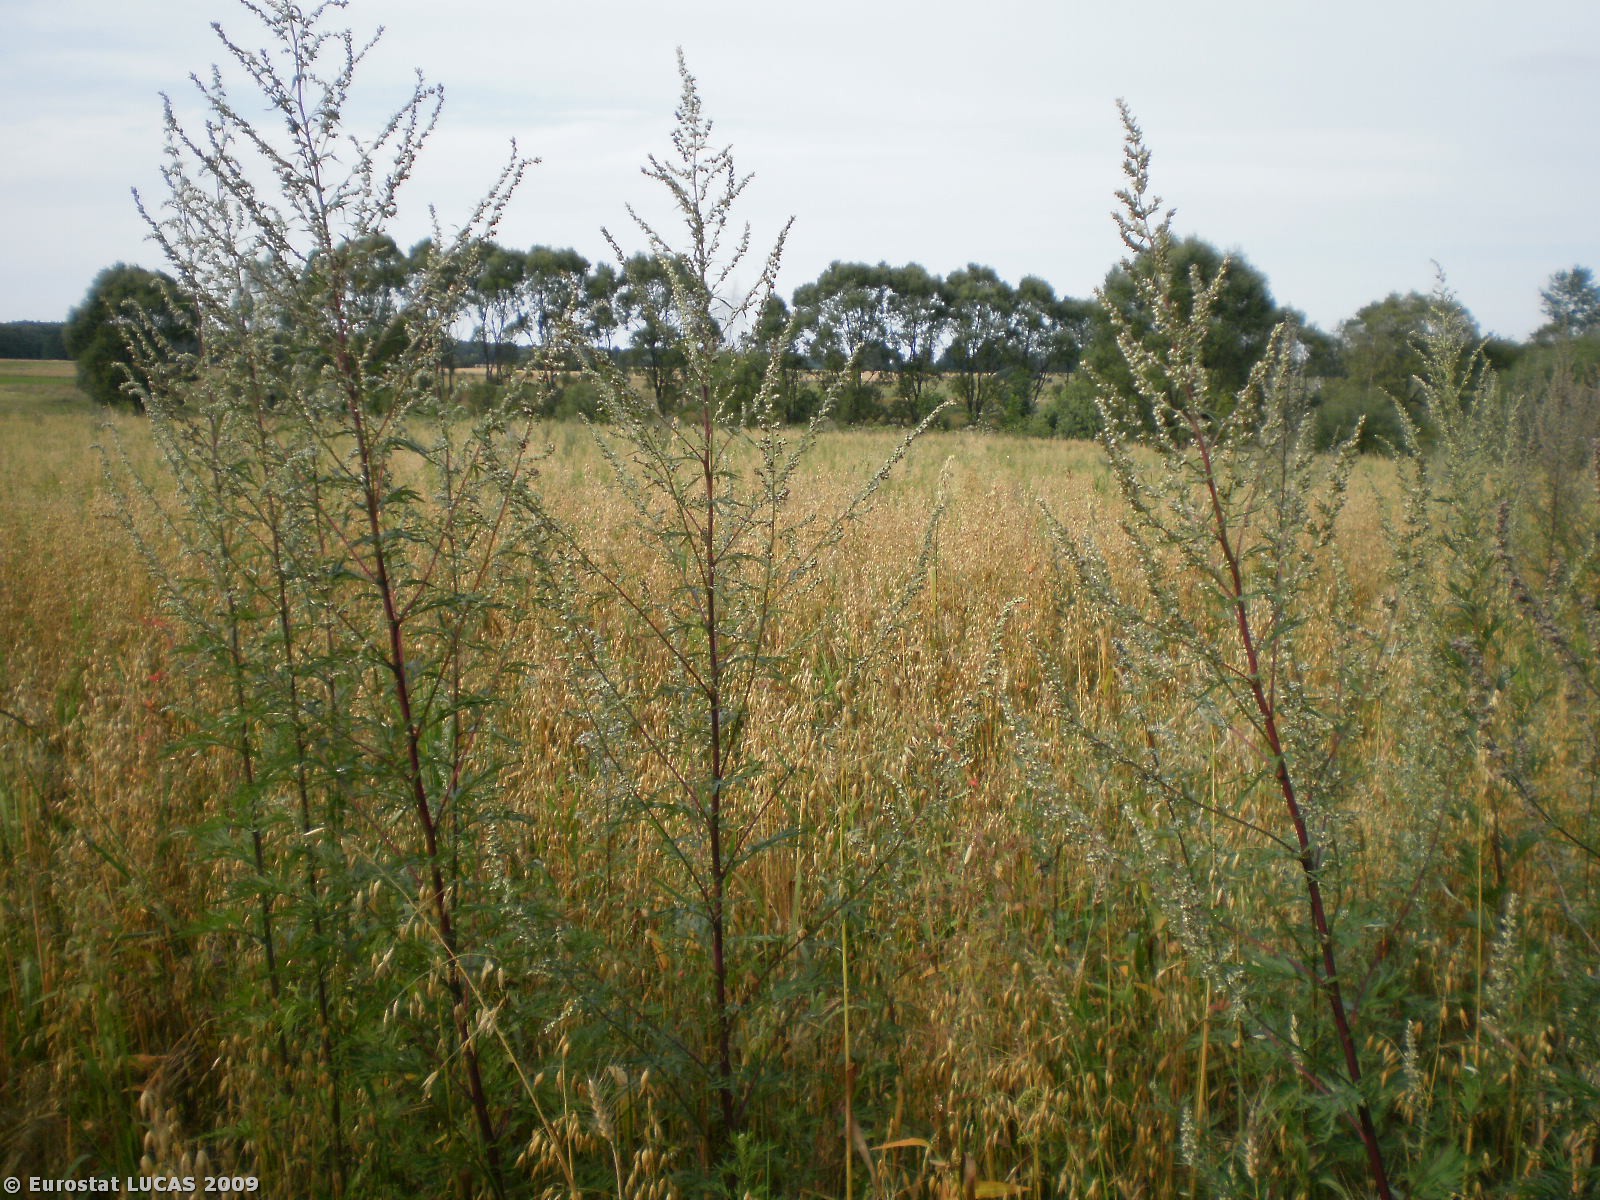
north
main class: Cropland
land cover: Mixed cereals for fodder
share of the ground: > 75 %
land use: Agriculture (excluding fallow land and kitchen gardens)
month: August
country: PL
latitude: 54.2651
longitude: 19.6537
